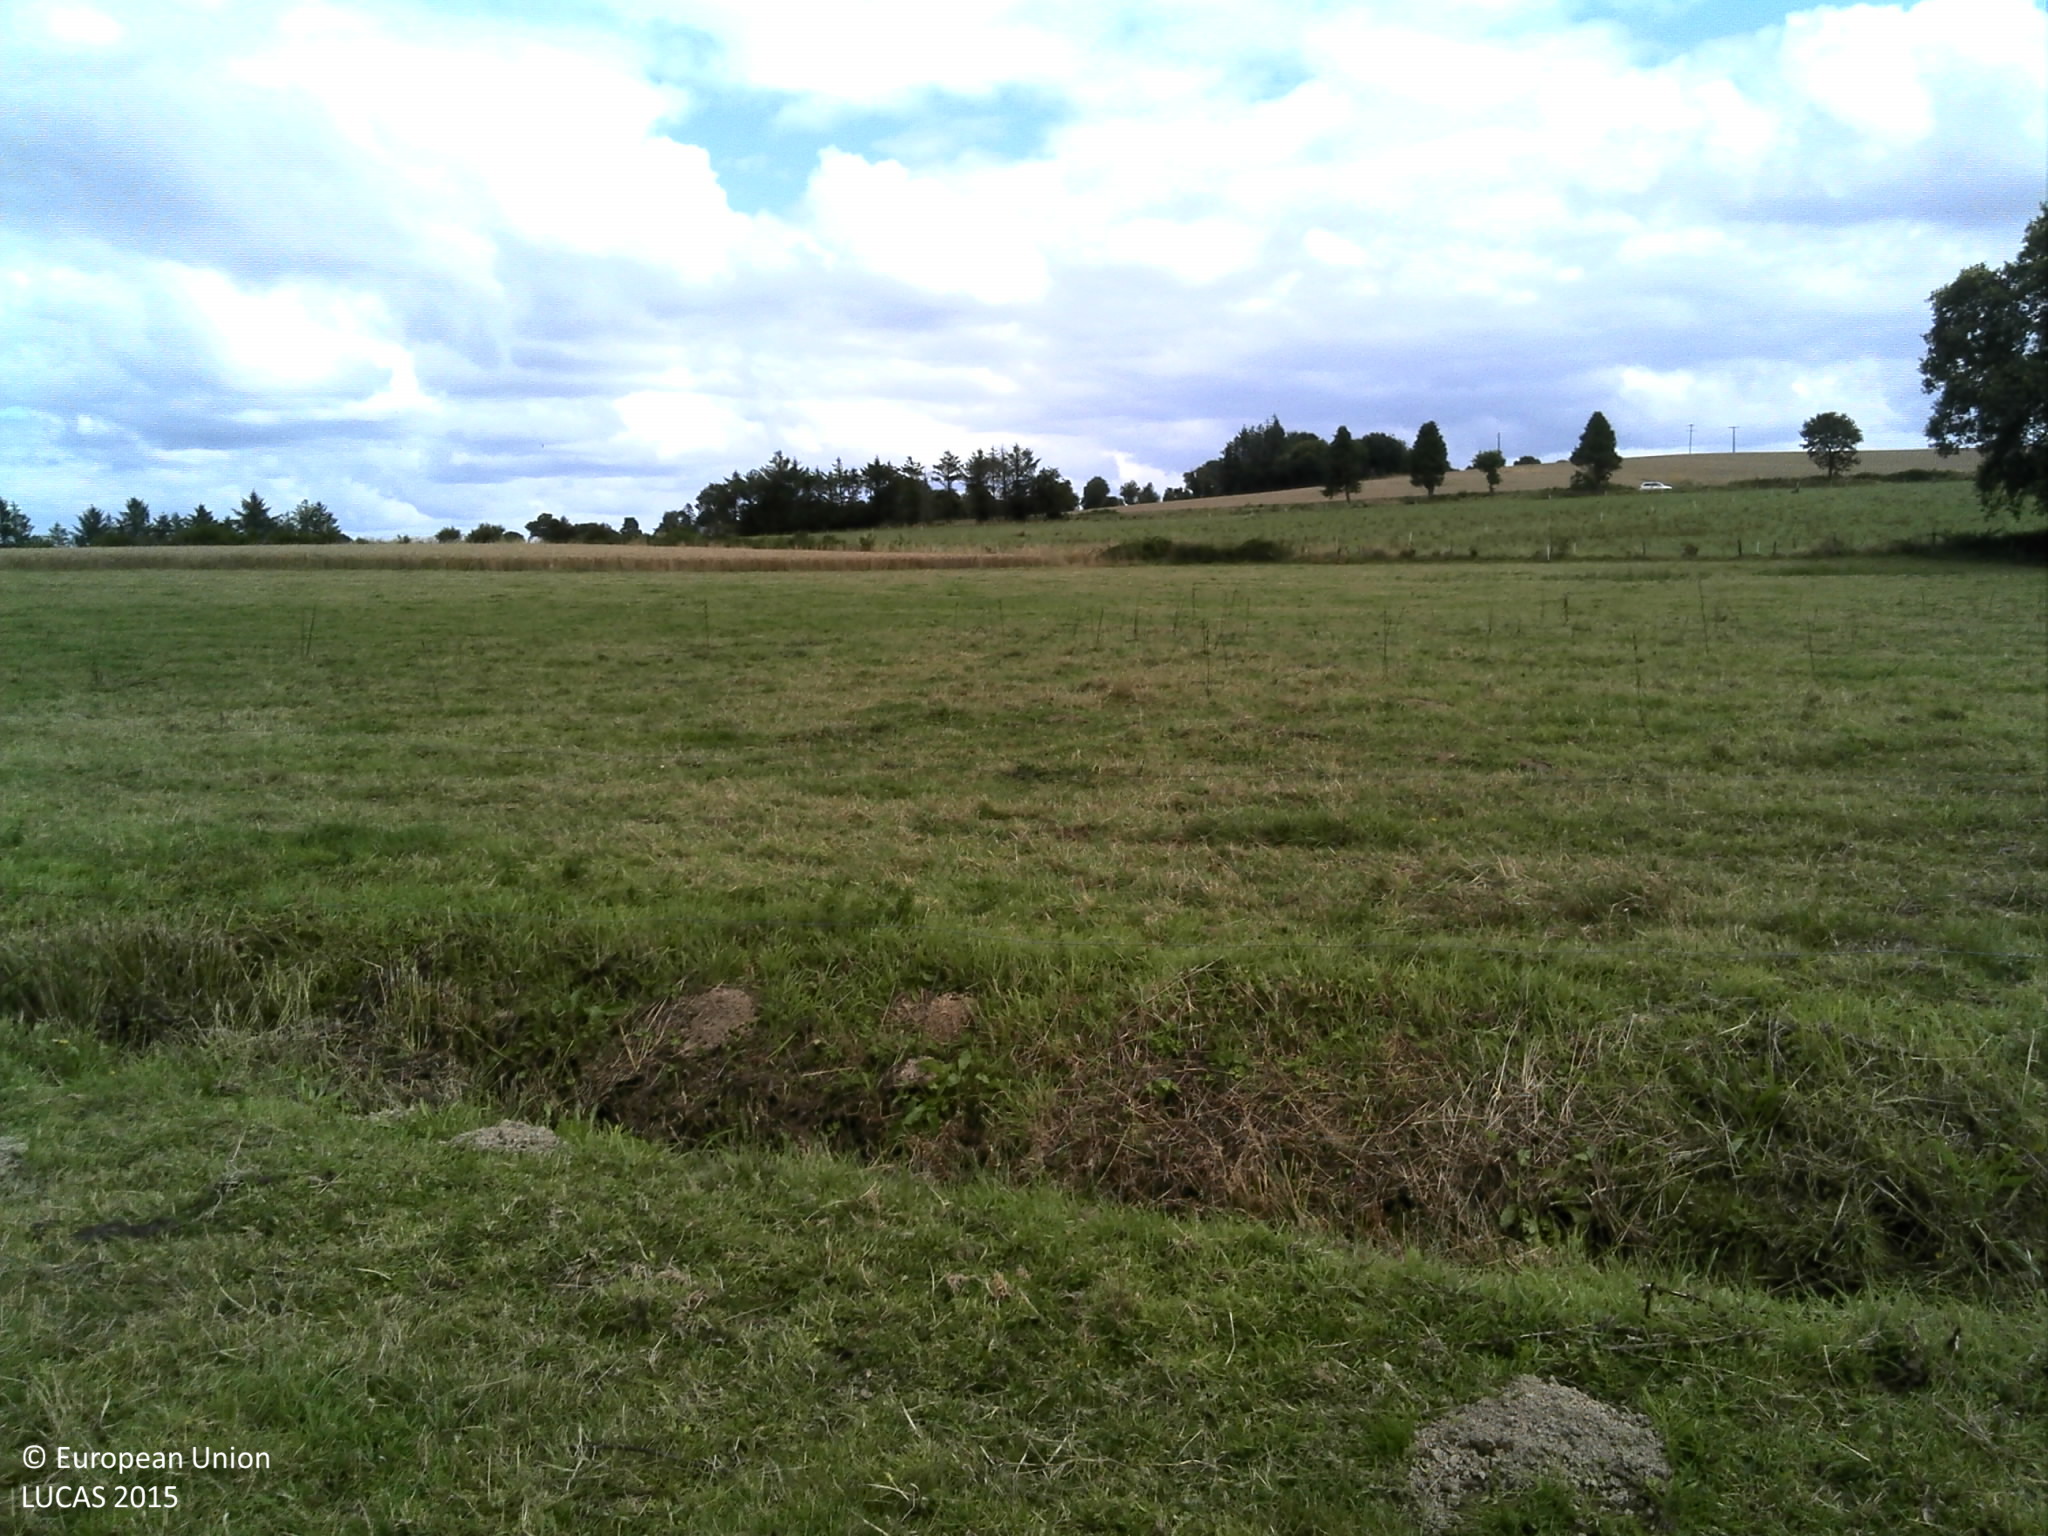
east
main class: Grassland
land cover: Grassland without tree/shrub cover
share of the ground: > 75 %
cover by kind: herbaceous plants 100 %
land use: Agriculture (excluding fallow land and kitchen gardens)
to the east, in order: Grassland without tree/shrub cover; Fences; Ditches and canals; Fences; Grassland without tree/shrub cover; Fences; Common wheat; Fences; Grass margins; Fences; Grassland without tree/shrub cover; Fences; Grassland without tree/shrub cover
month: July
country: FR
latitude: 48.2784
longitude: -3.6777
